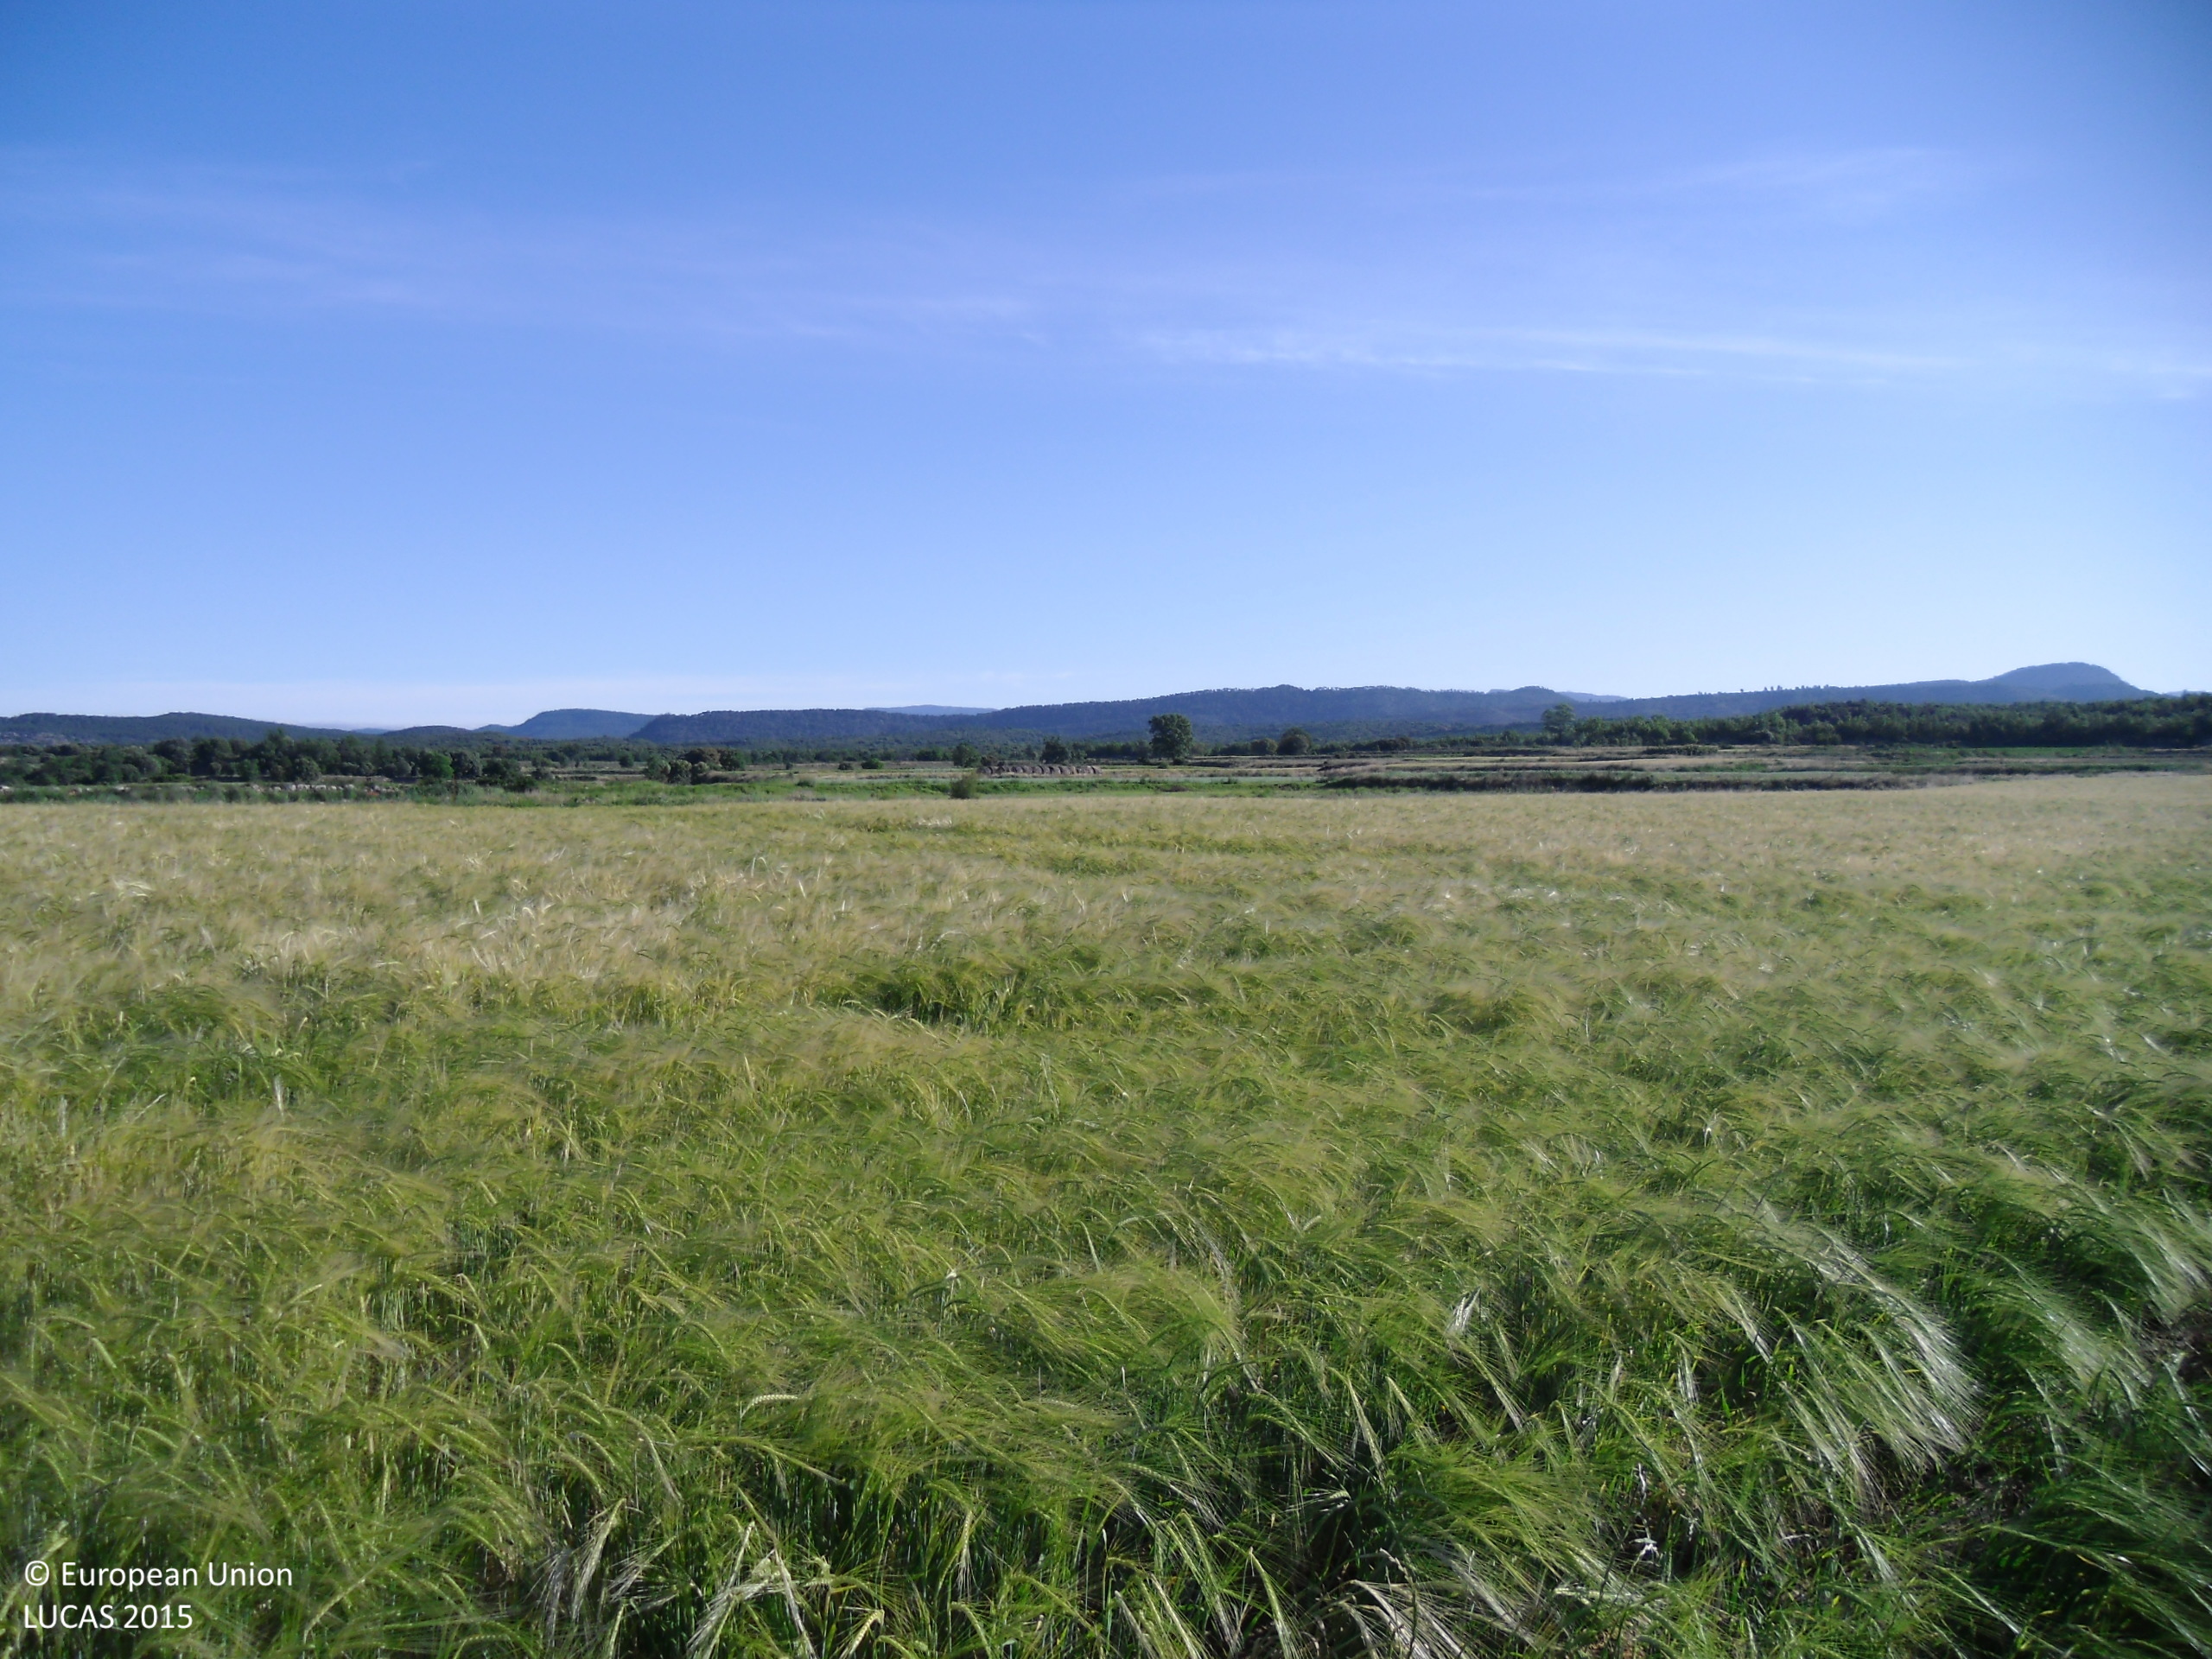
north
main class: Cropland
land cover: Barley
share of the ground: > 75 %
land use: Agriculture (excluding fallow land and kitchen gardens)
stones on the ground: < 10 %
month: May
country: ES
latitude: 40.2337
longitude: -0.8089
